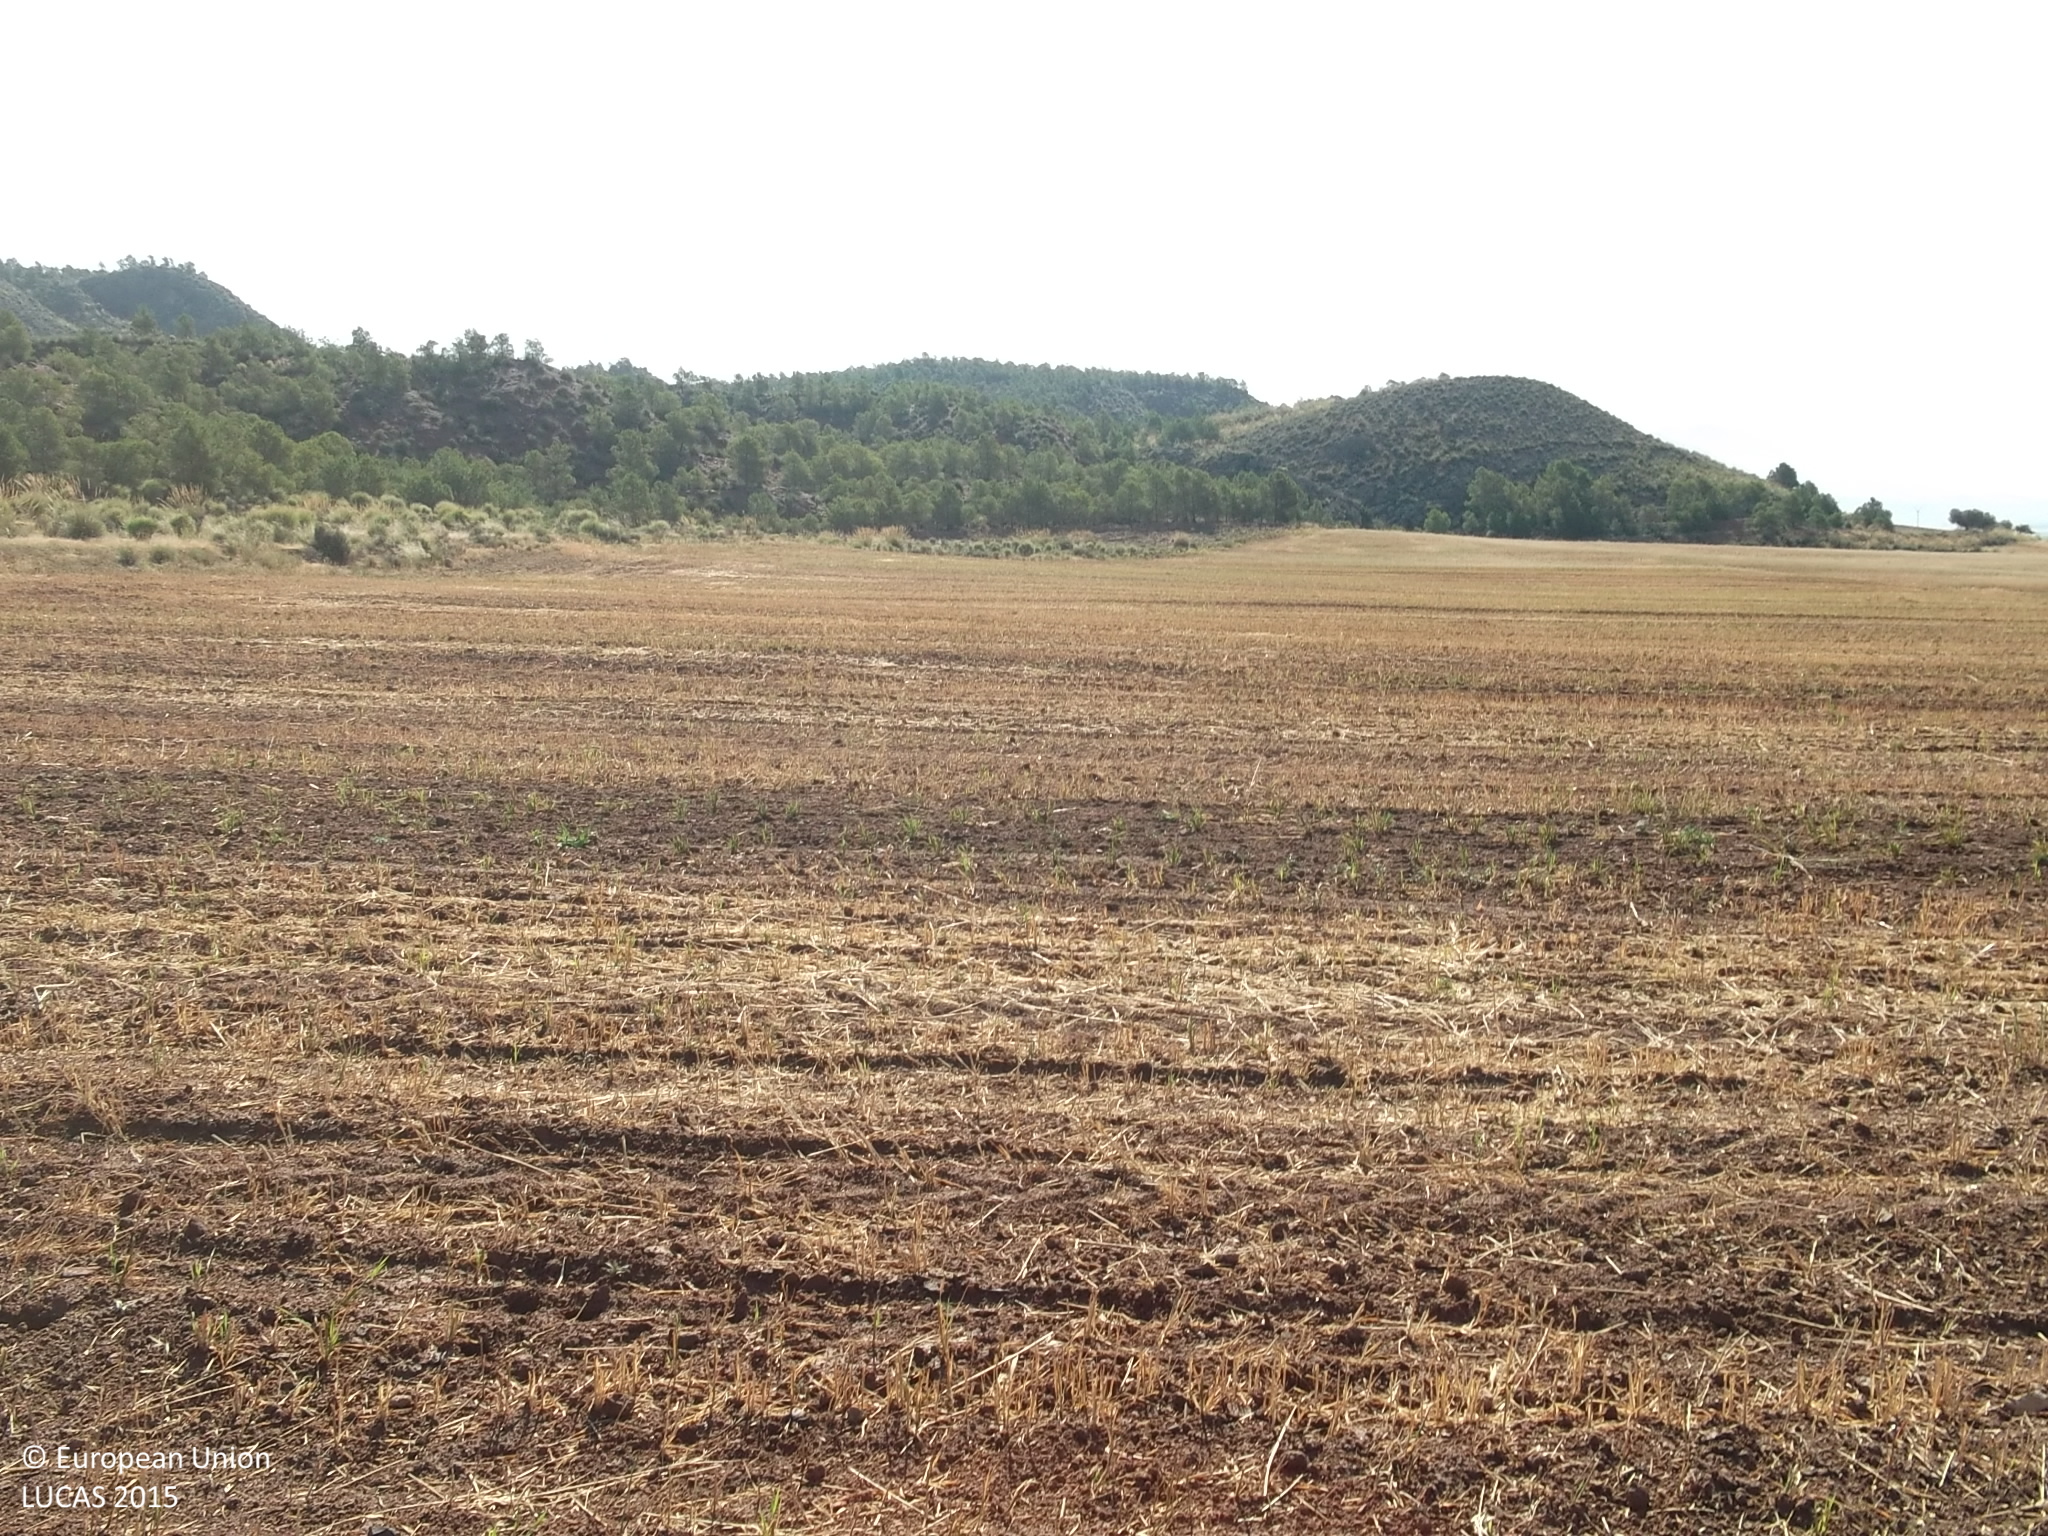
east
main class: Cropland
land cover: Oats
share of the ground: > 75 %
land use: Agriculture (excluding fallow land and kitchen gardens)
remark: Harvested field
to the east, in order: Oats; Shrubland without tree cover; Pine dominated coniferous woodland
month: June
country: ES
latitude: 38.4712
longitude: -1.3725
